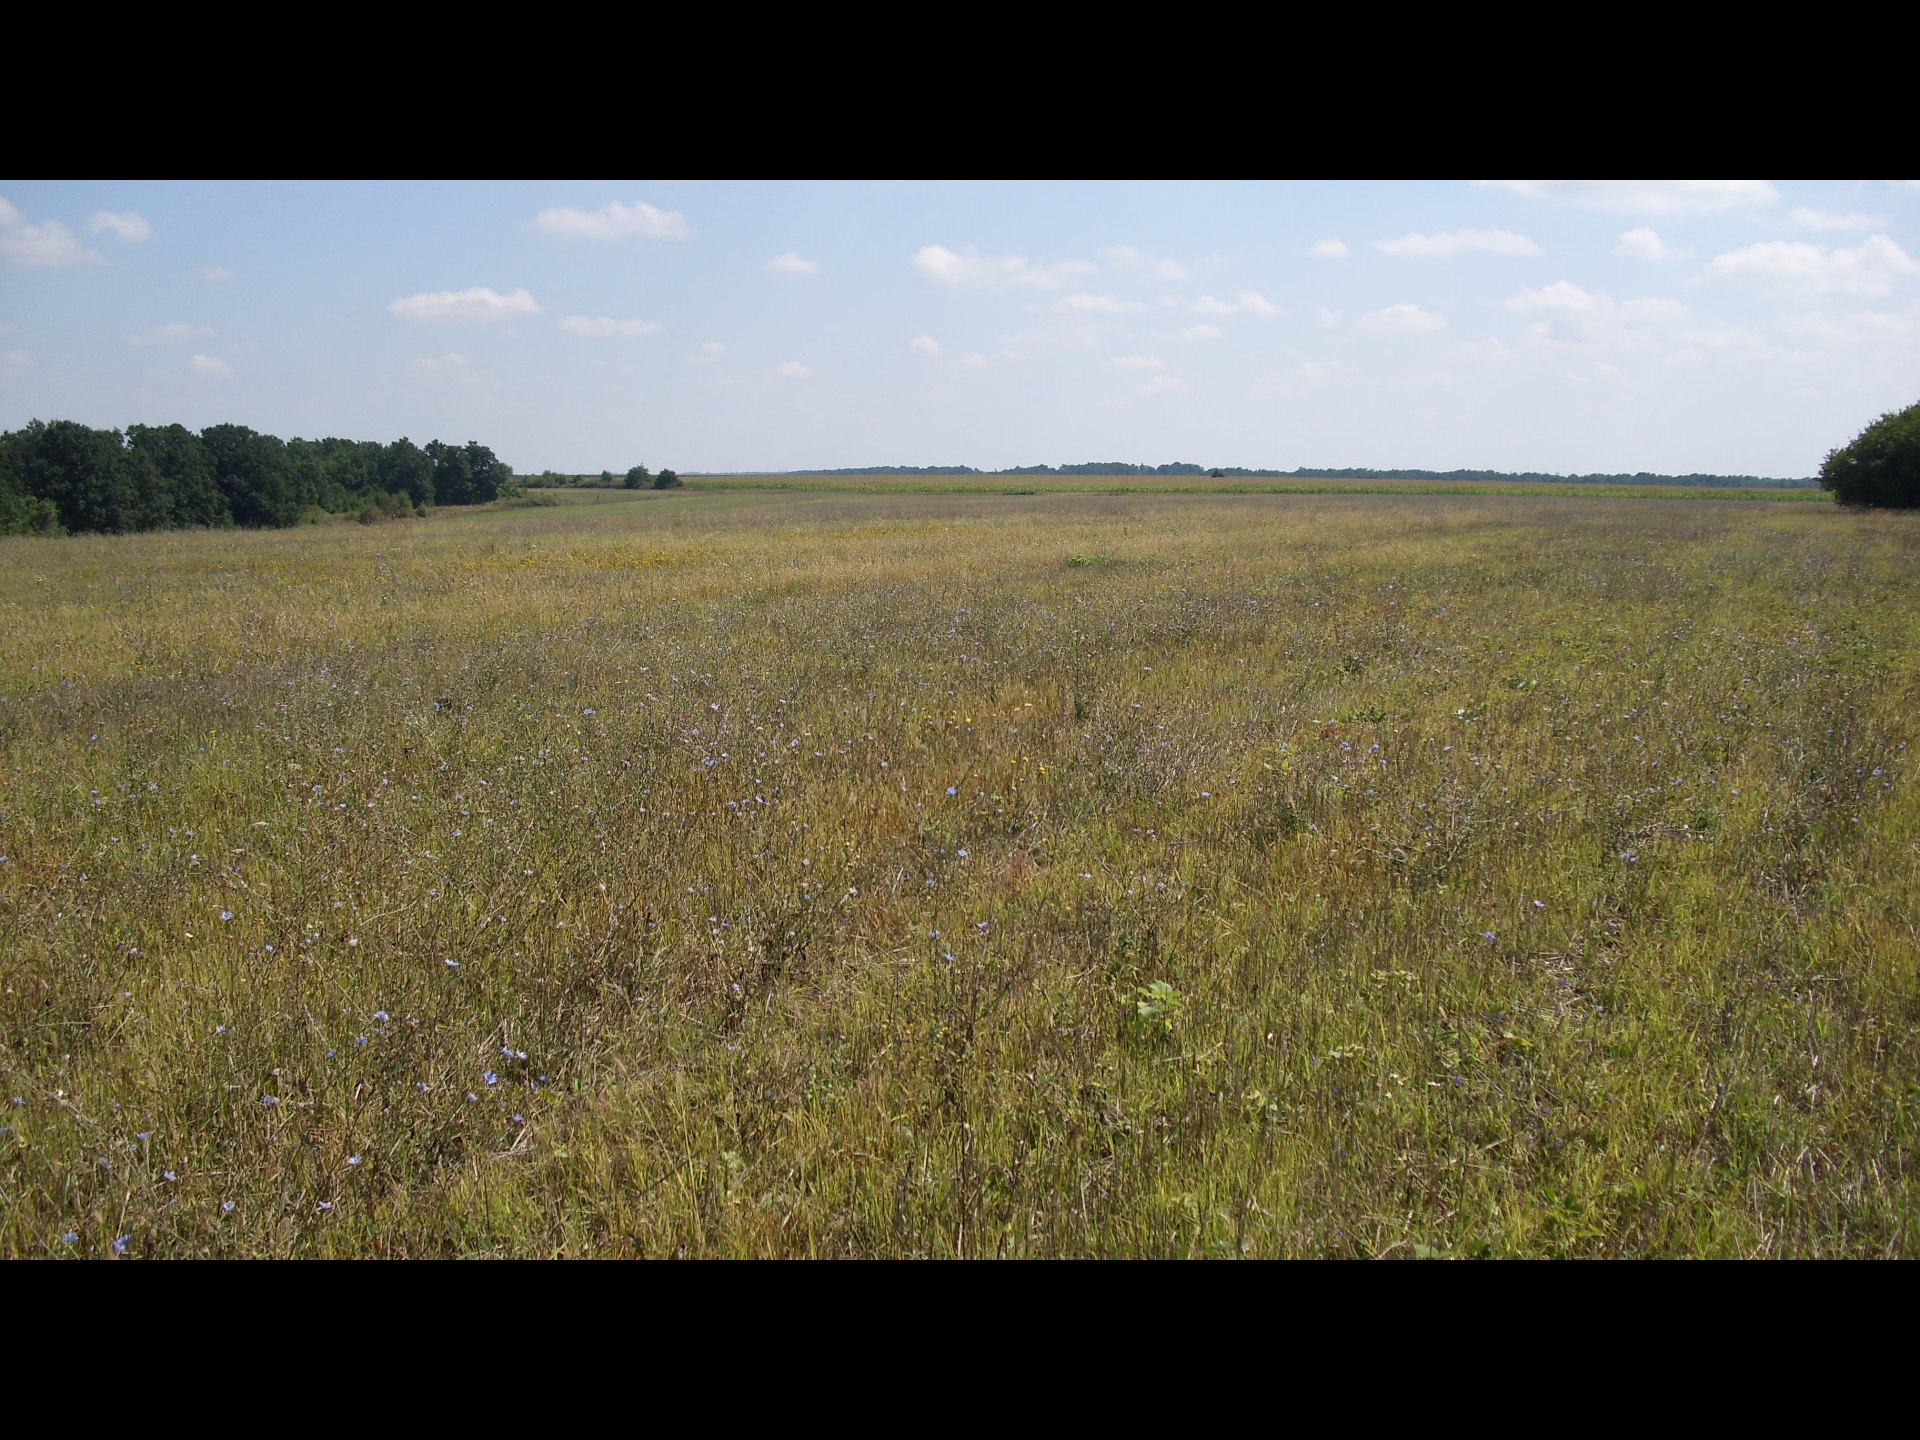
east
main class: Cropland
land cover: Common wheat
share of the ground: 10 - 25 %
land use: Agriculture (excluding fallow land and kitchen gardens)
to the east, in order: Common wheat
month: August
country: BG
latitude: 43.6008
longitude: 23.0085
